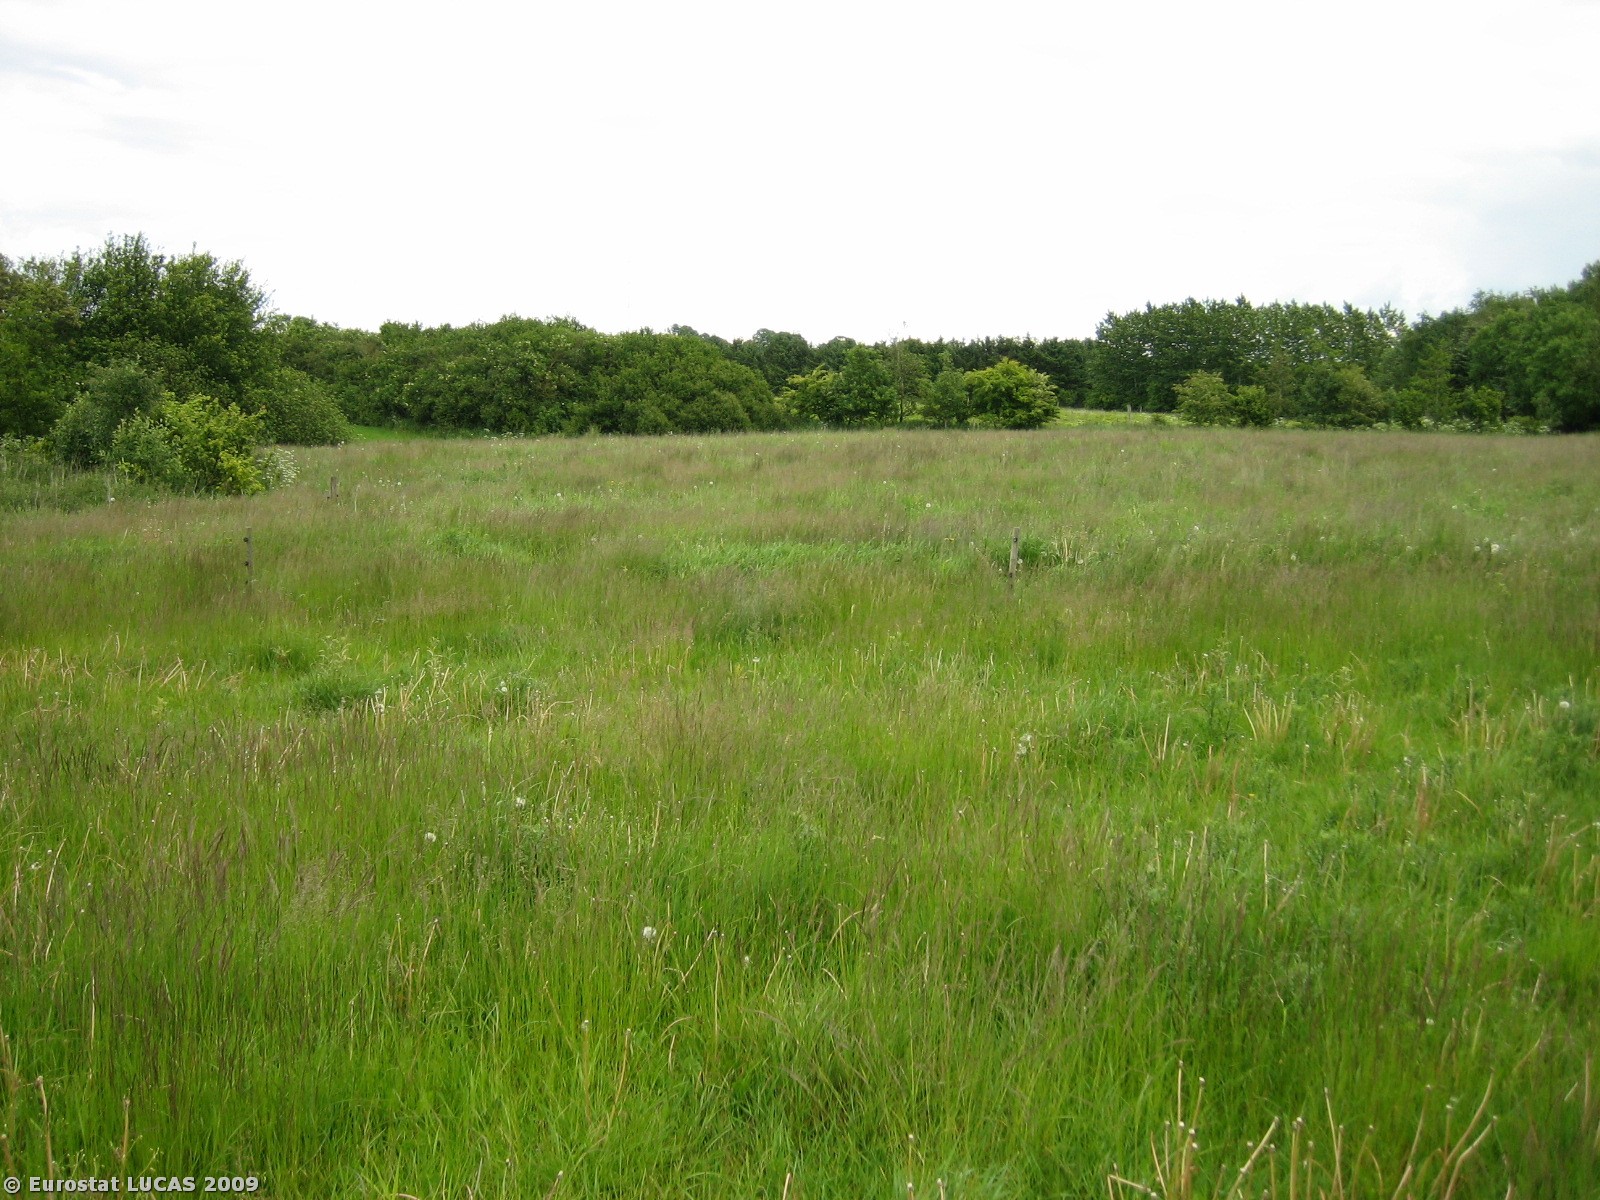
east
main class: Grassland
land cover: Grassland without tree/shrub cover
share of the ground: > 75 %
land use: Agriculture (excluding fallow land and kitchen gardens)
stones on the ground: < 10 %
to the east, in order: Grassland without tree/shrub cover; Fences; Grassland without tree/shrub cover; Fences; Shrubland without tree cover; Grass margins; Fences; Coniferous woodland
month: June
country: DK
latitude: 56.2956
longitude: 9.9193
